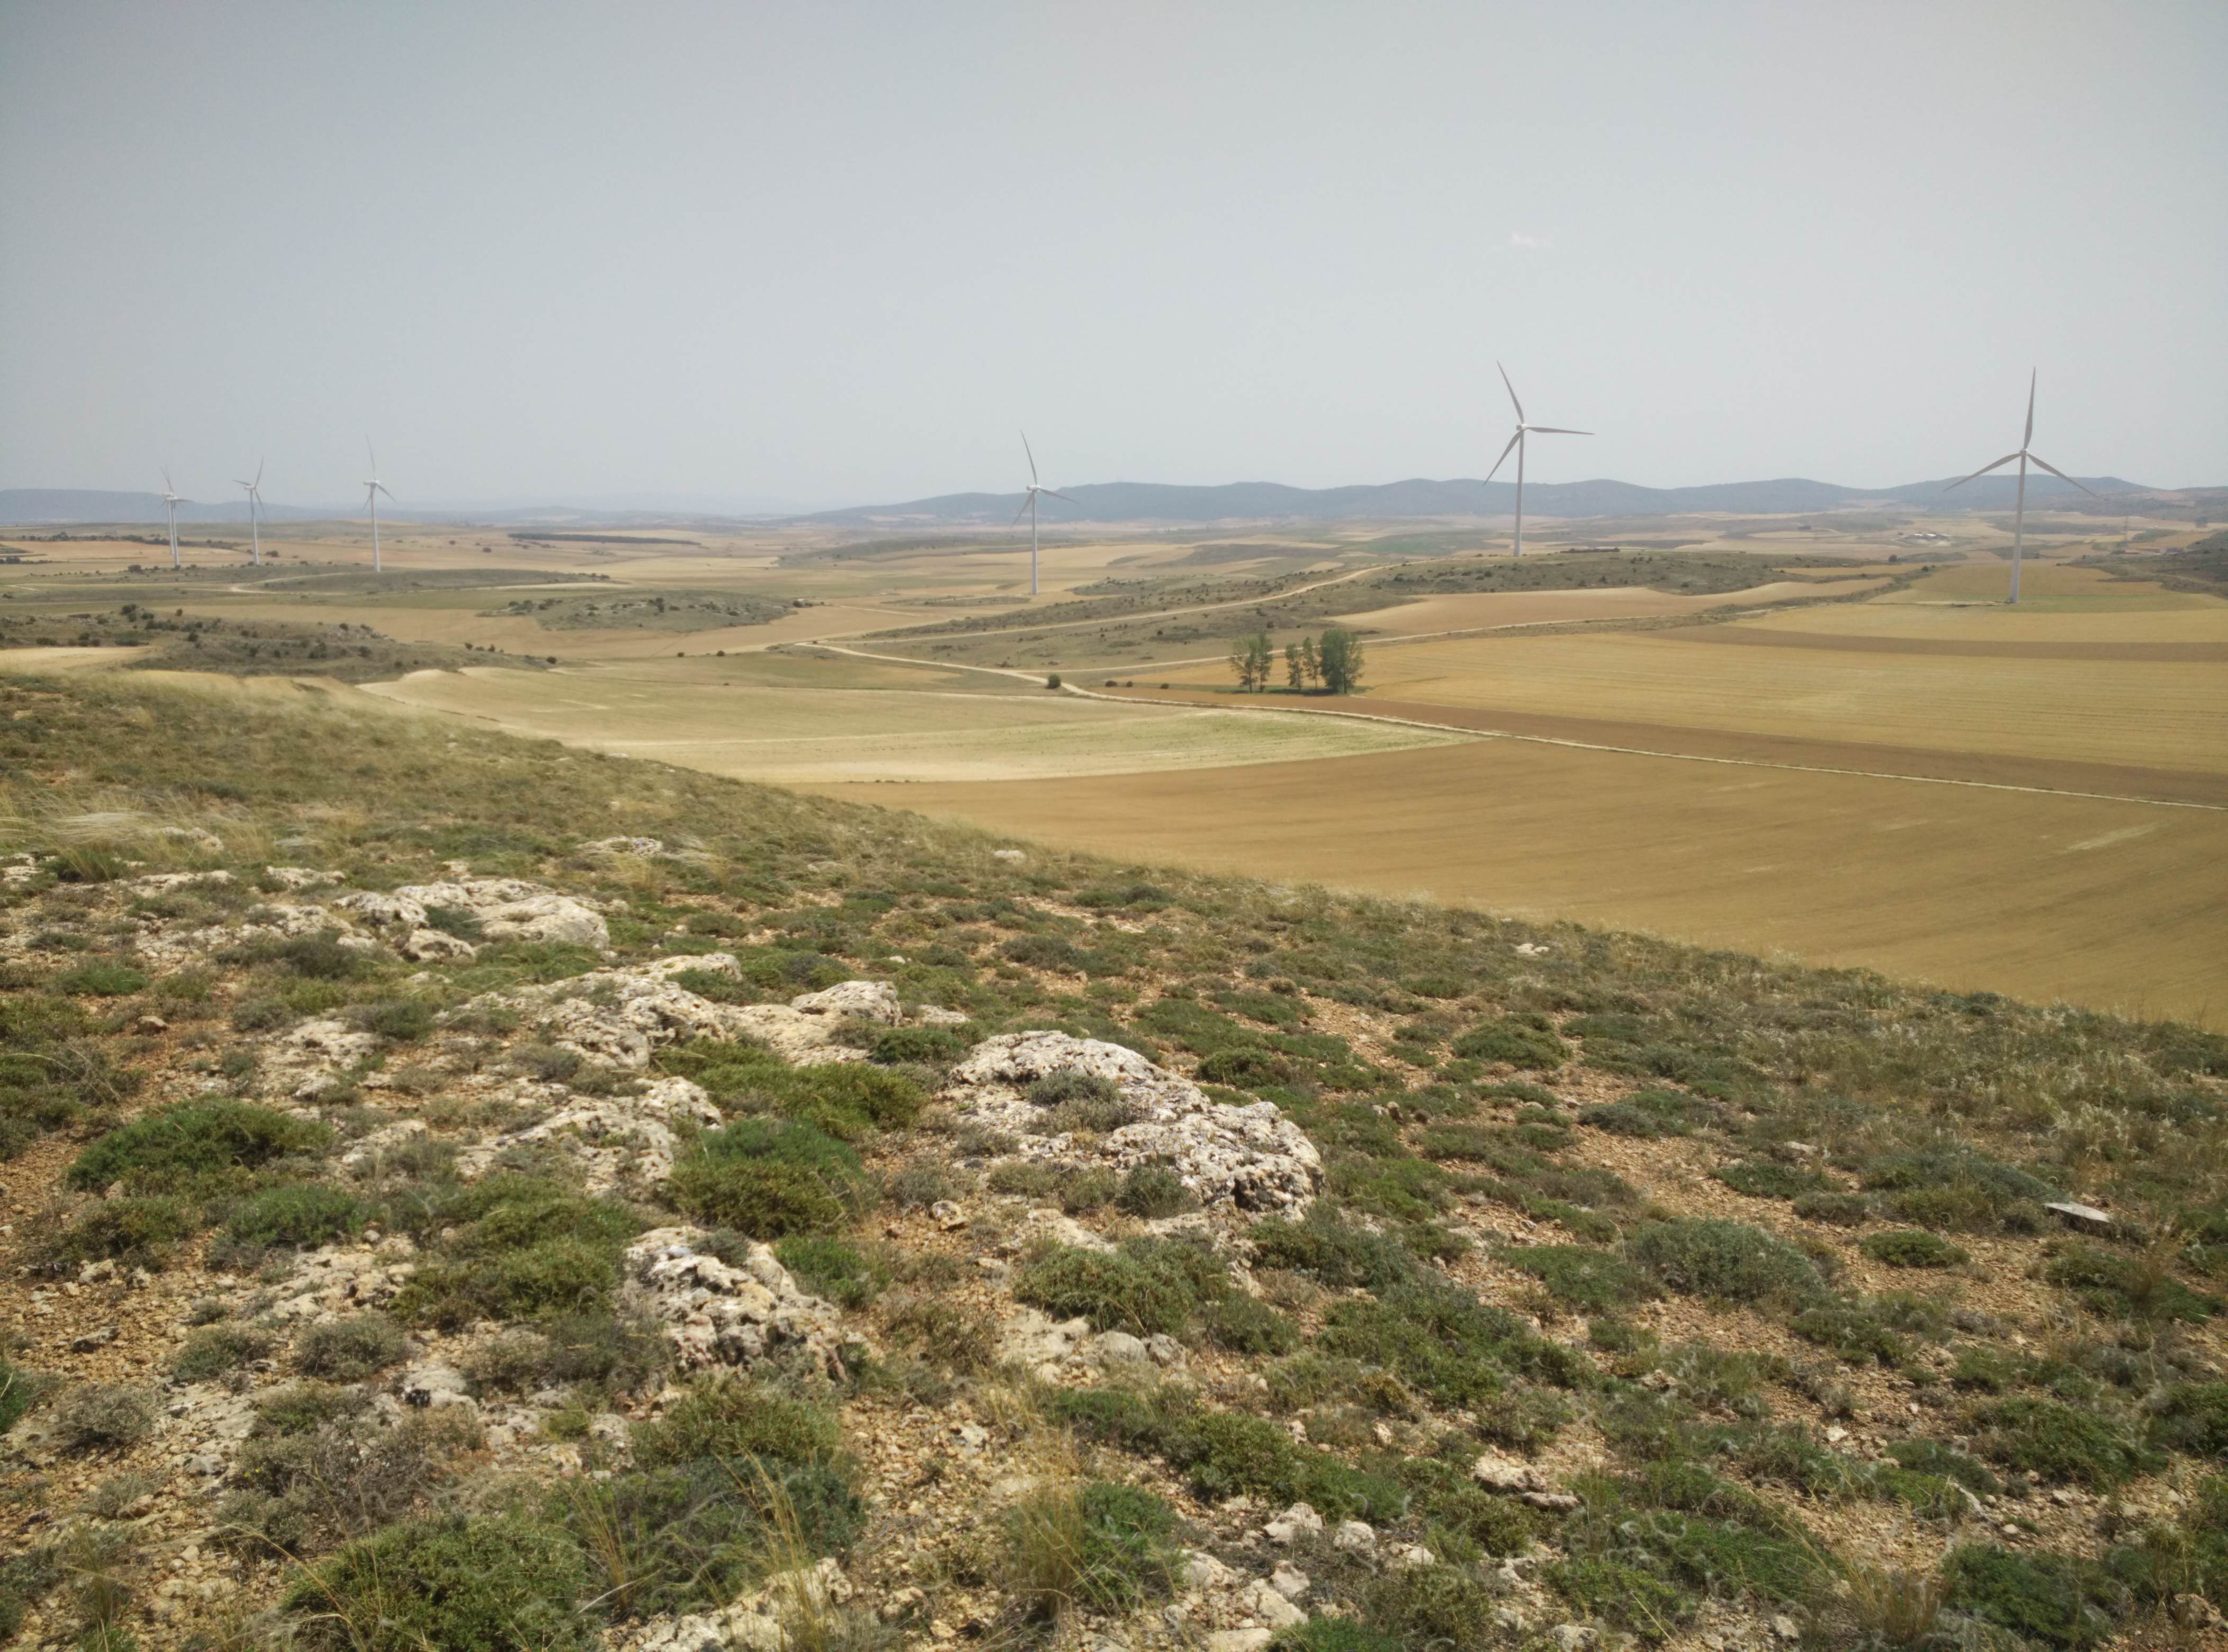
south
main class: Shrubland
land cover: Shrubland without tree cover
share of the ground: > 75 %
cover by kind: shrubs 80 %, unconsolidated bare surface 10 %, herbaceous plants 5 %, consolidated bare surface 5 %
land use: Semi-natural and natural areas not in use
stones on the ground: > 50 %
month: July
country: ES
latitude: 41.0189
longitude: -1.9042
